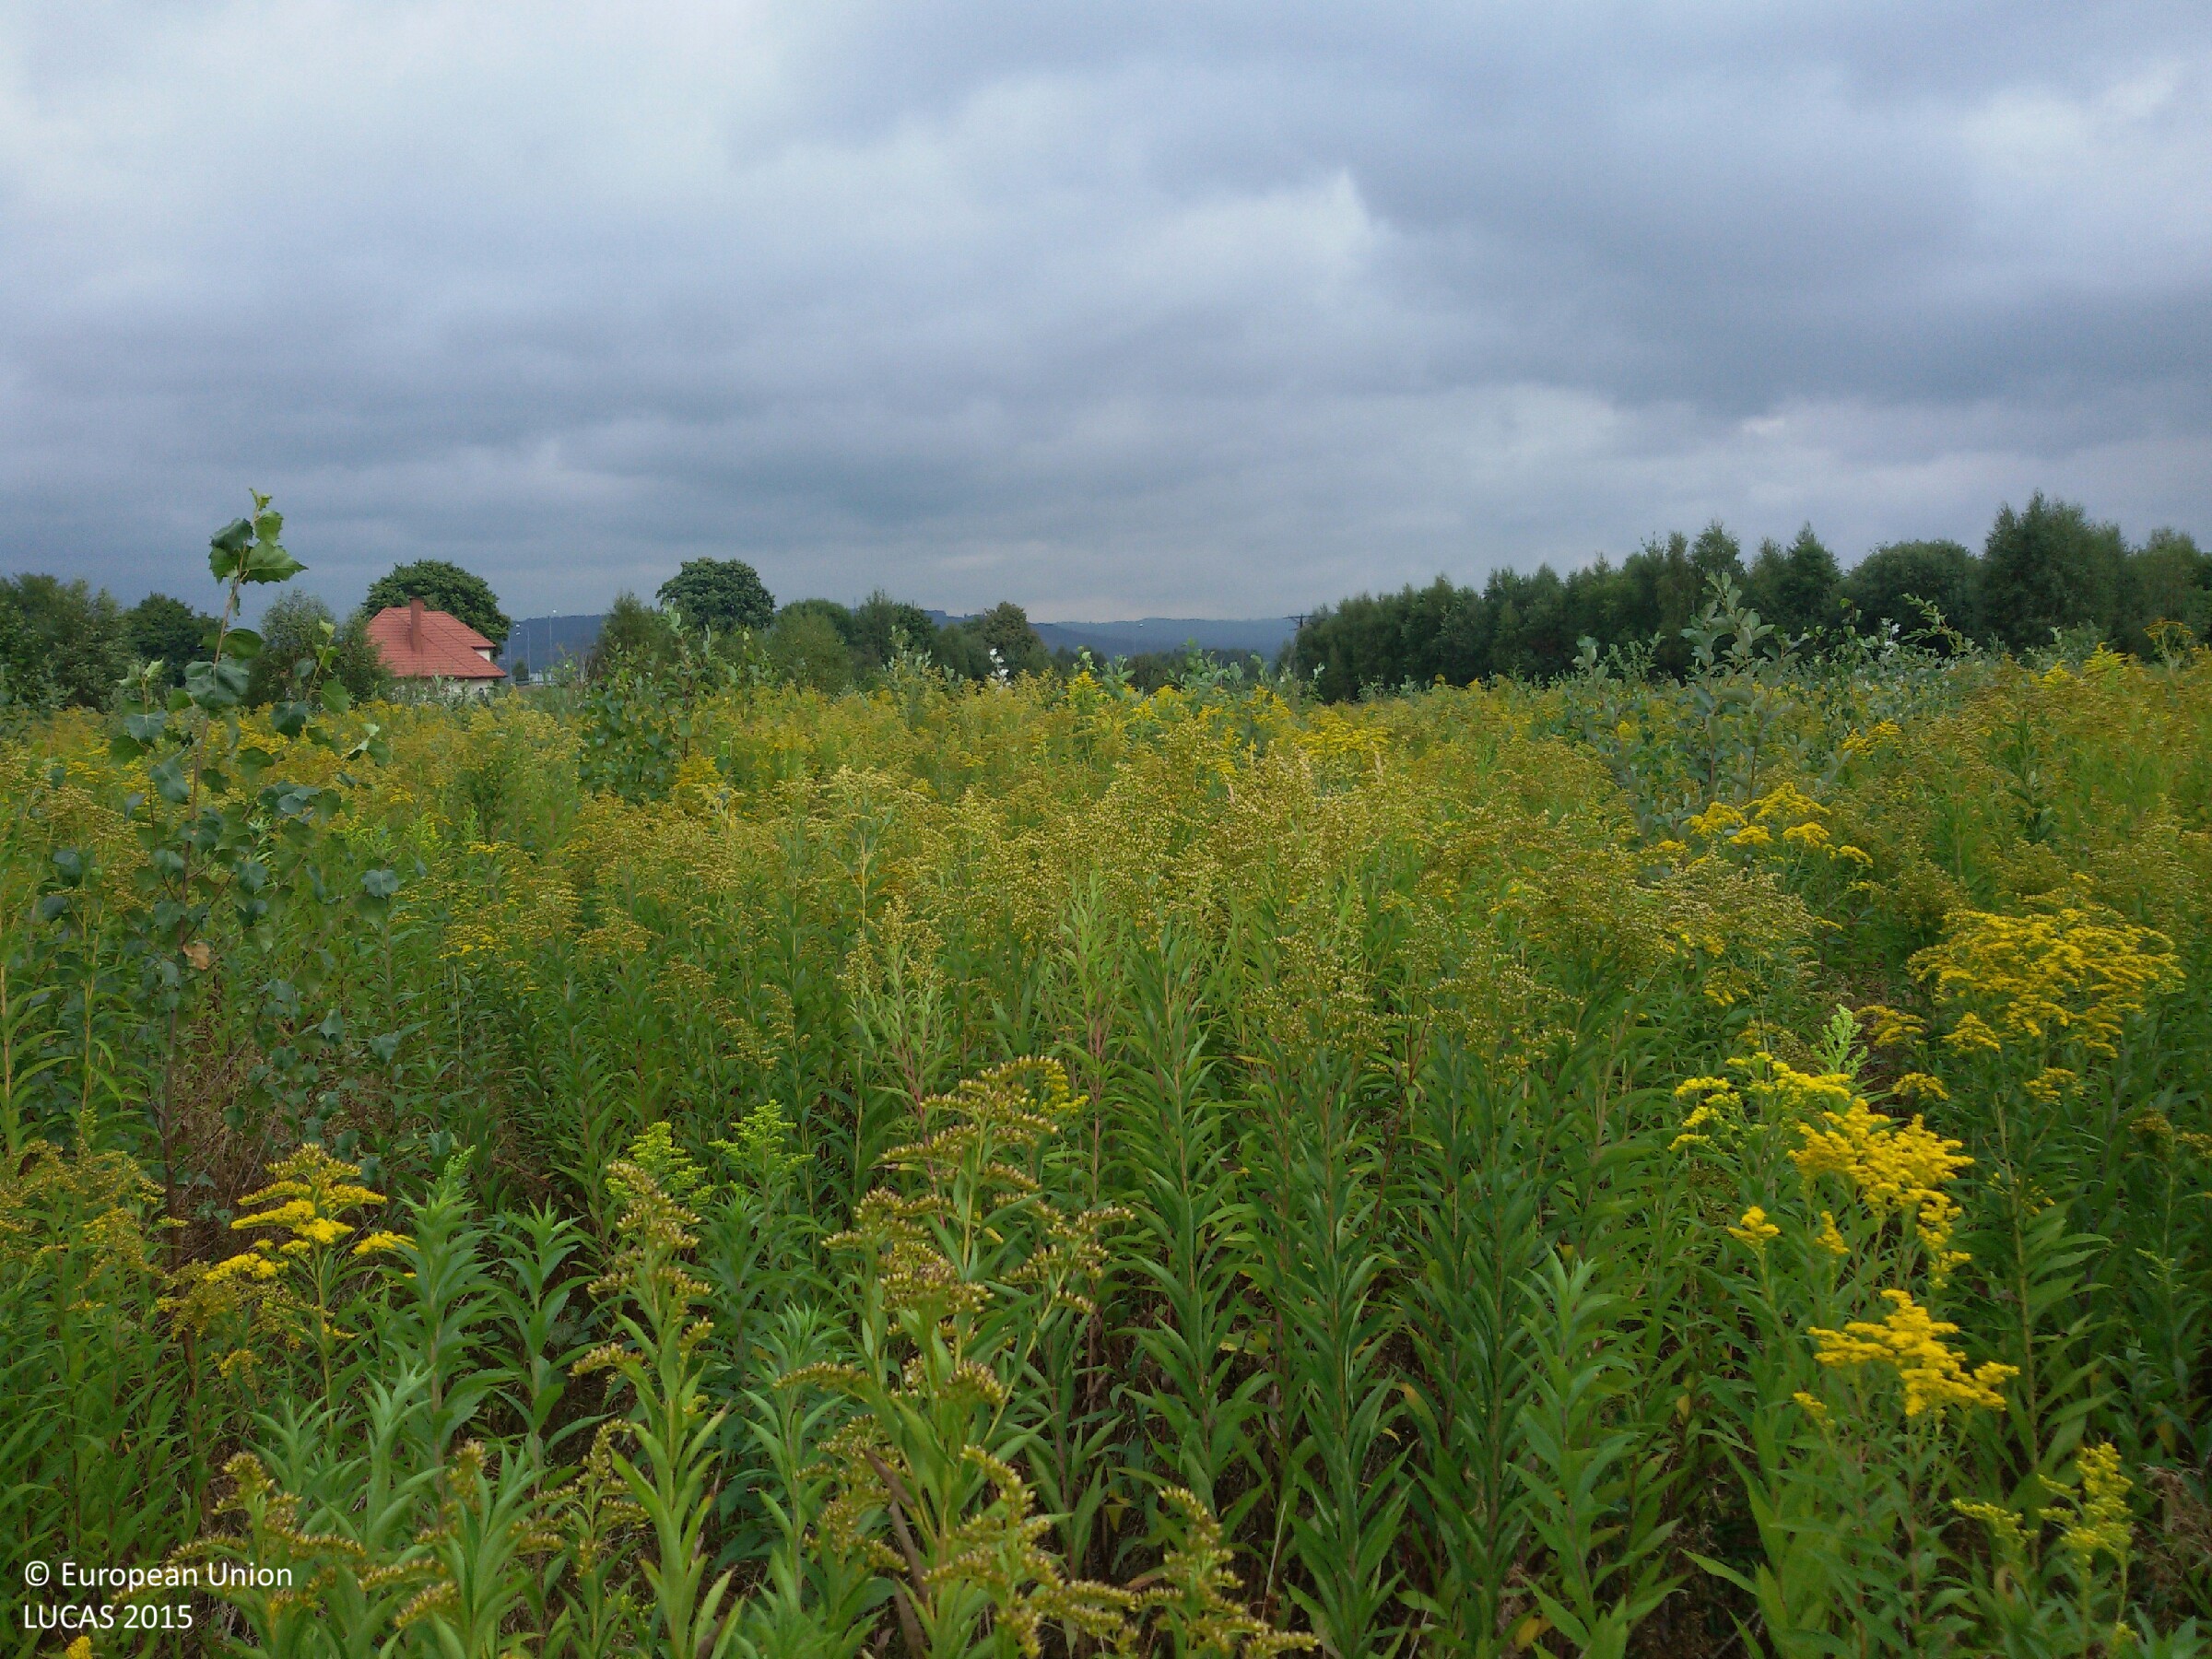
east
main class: Grassland
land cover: Spontaneously vegetated surfaces
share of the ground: > 75 %
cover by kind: herbaceous plants 100 %
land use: Fallow land
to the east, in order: Spontaneously vegetated surfaces; Grassland without tree/shrub cover; Tracks; Grassland without tree/shrub cover; Electric lines; Grassland without tree/shrub cover; Broadleaved woodland
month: September
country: PL
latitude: 49.9862
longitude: 21.2745
